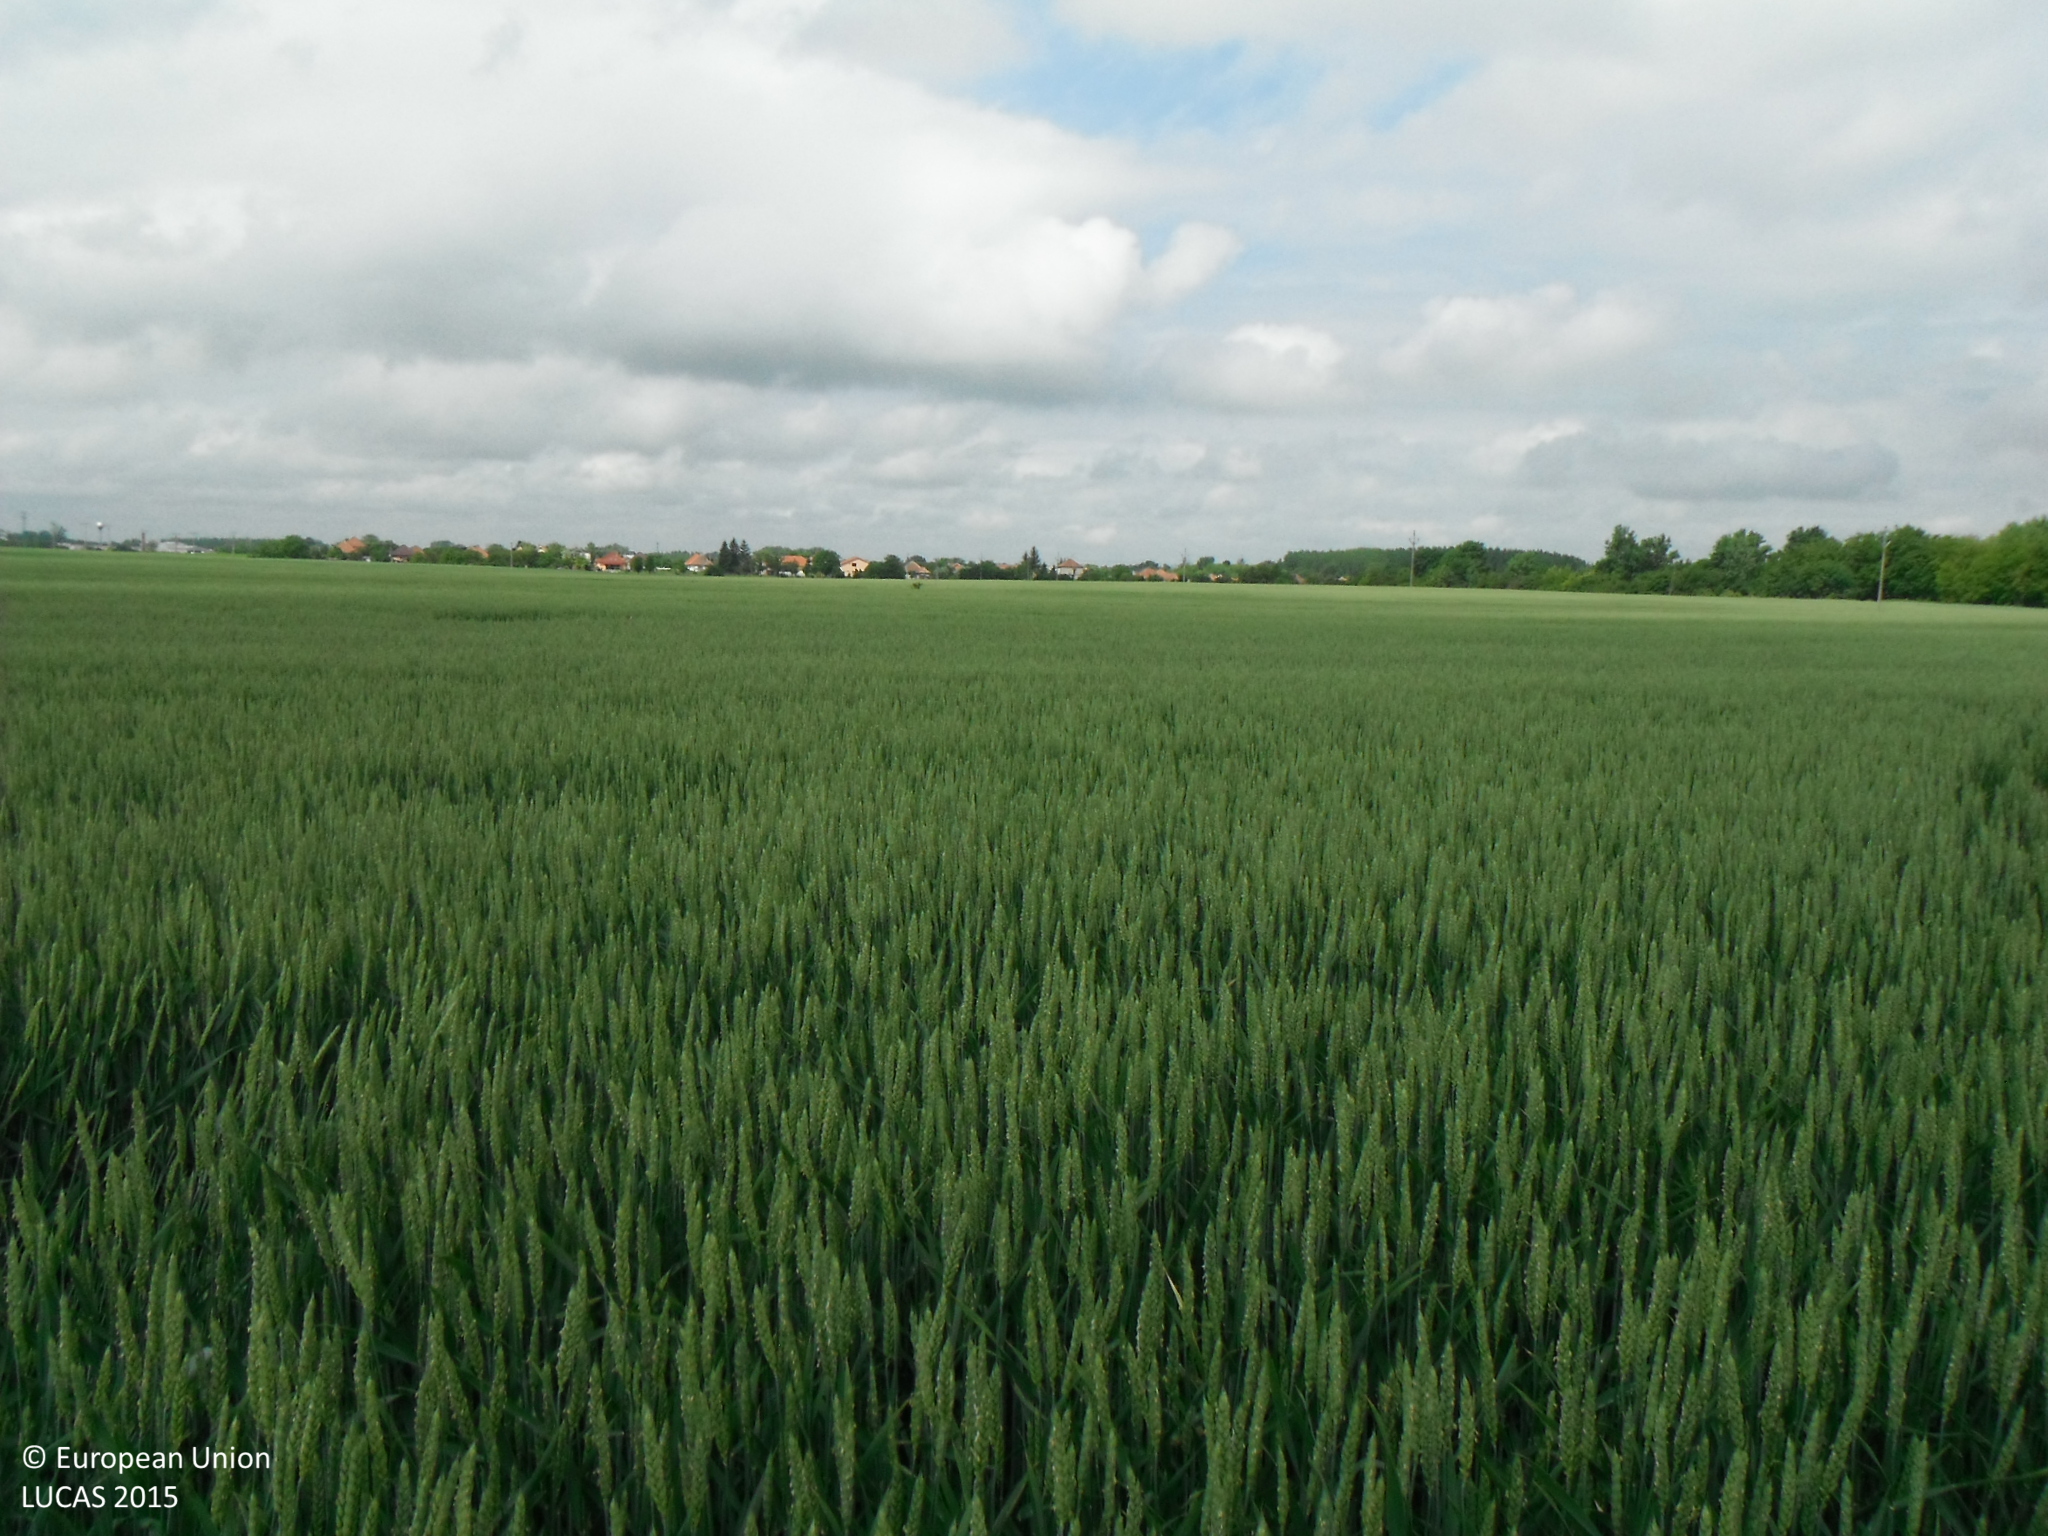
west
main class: Cropland
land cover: Common wheat
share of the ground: > 75 %
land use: Agriculture (excluding fallow land and kitchen gardens)
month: May
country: SK
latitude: 48.1528
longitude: 18.2003
